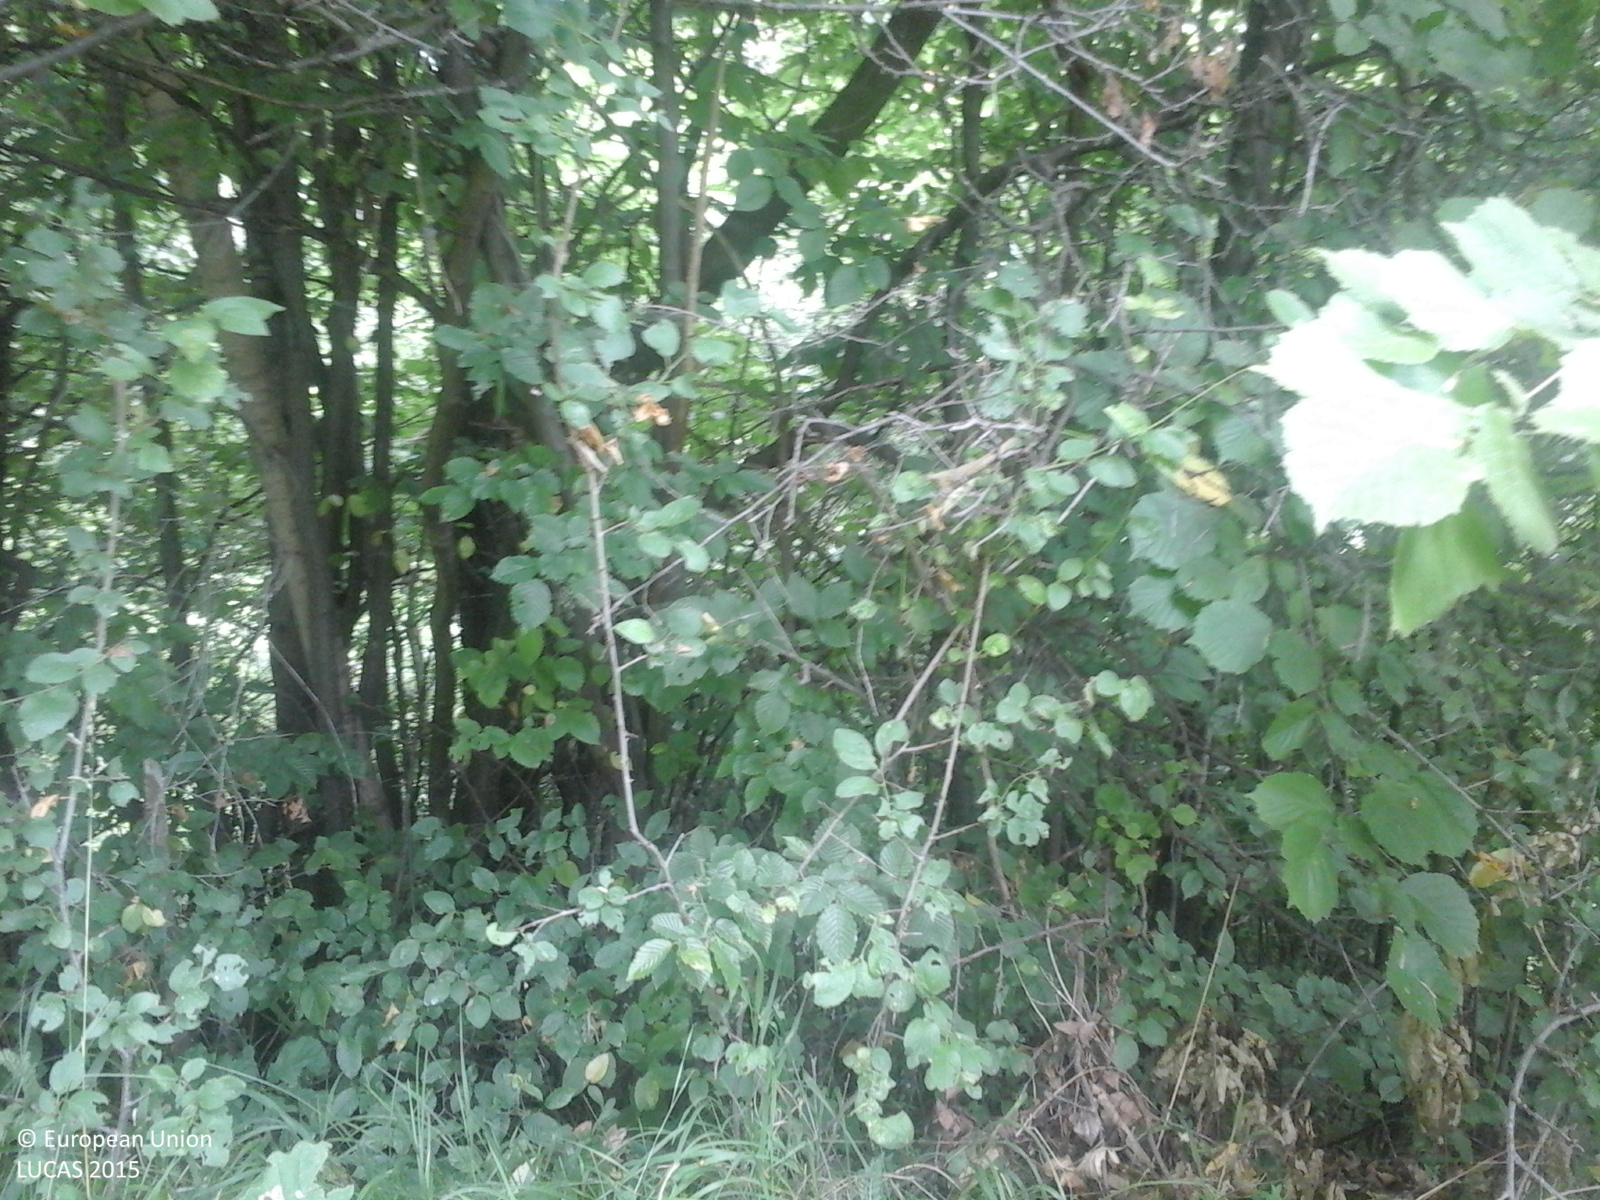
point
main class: Woodland
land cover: Broadleaved woodland
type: beech forest
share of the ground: > 75 %
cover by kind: broadleaved forest trees 100 %
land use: Forestry
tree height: > 5 m
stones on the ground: < 10 %
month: July
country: RO
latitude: 45.1889
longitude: 24.6533
